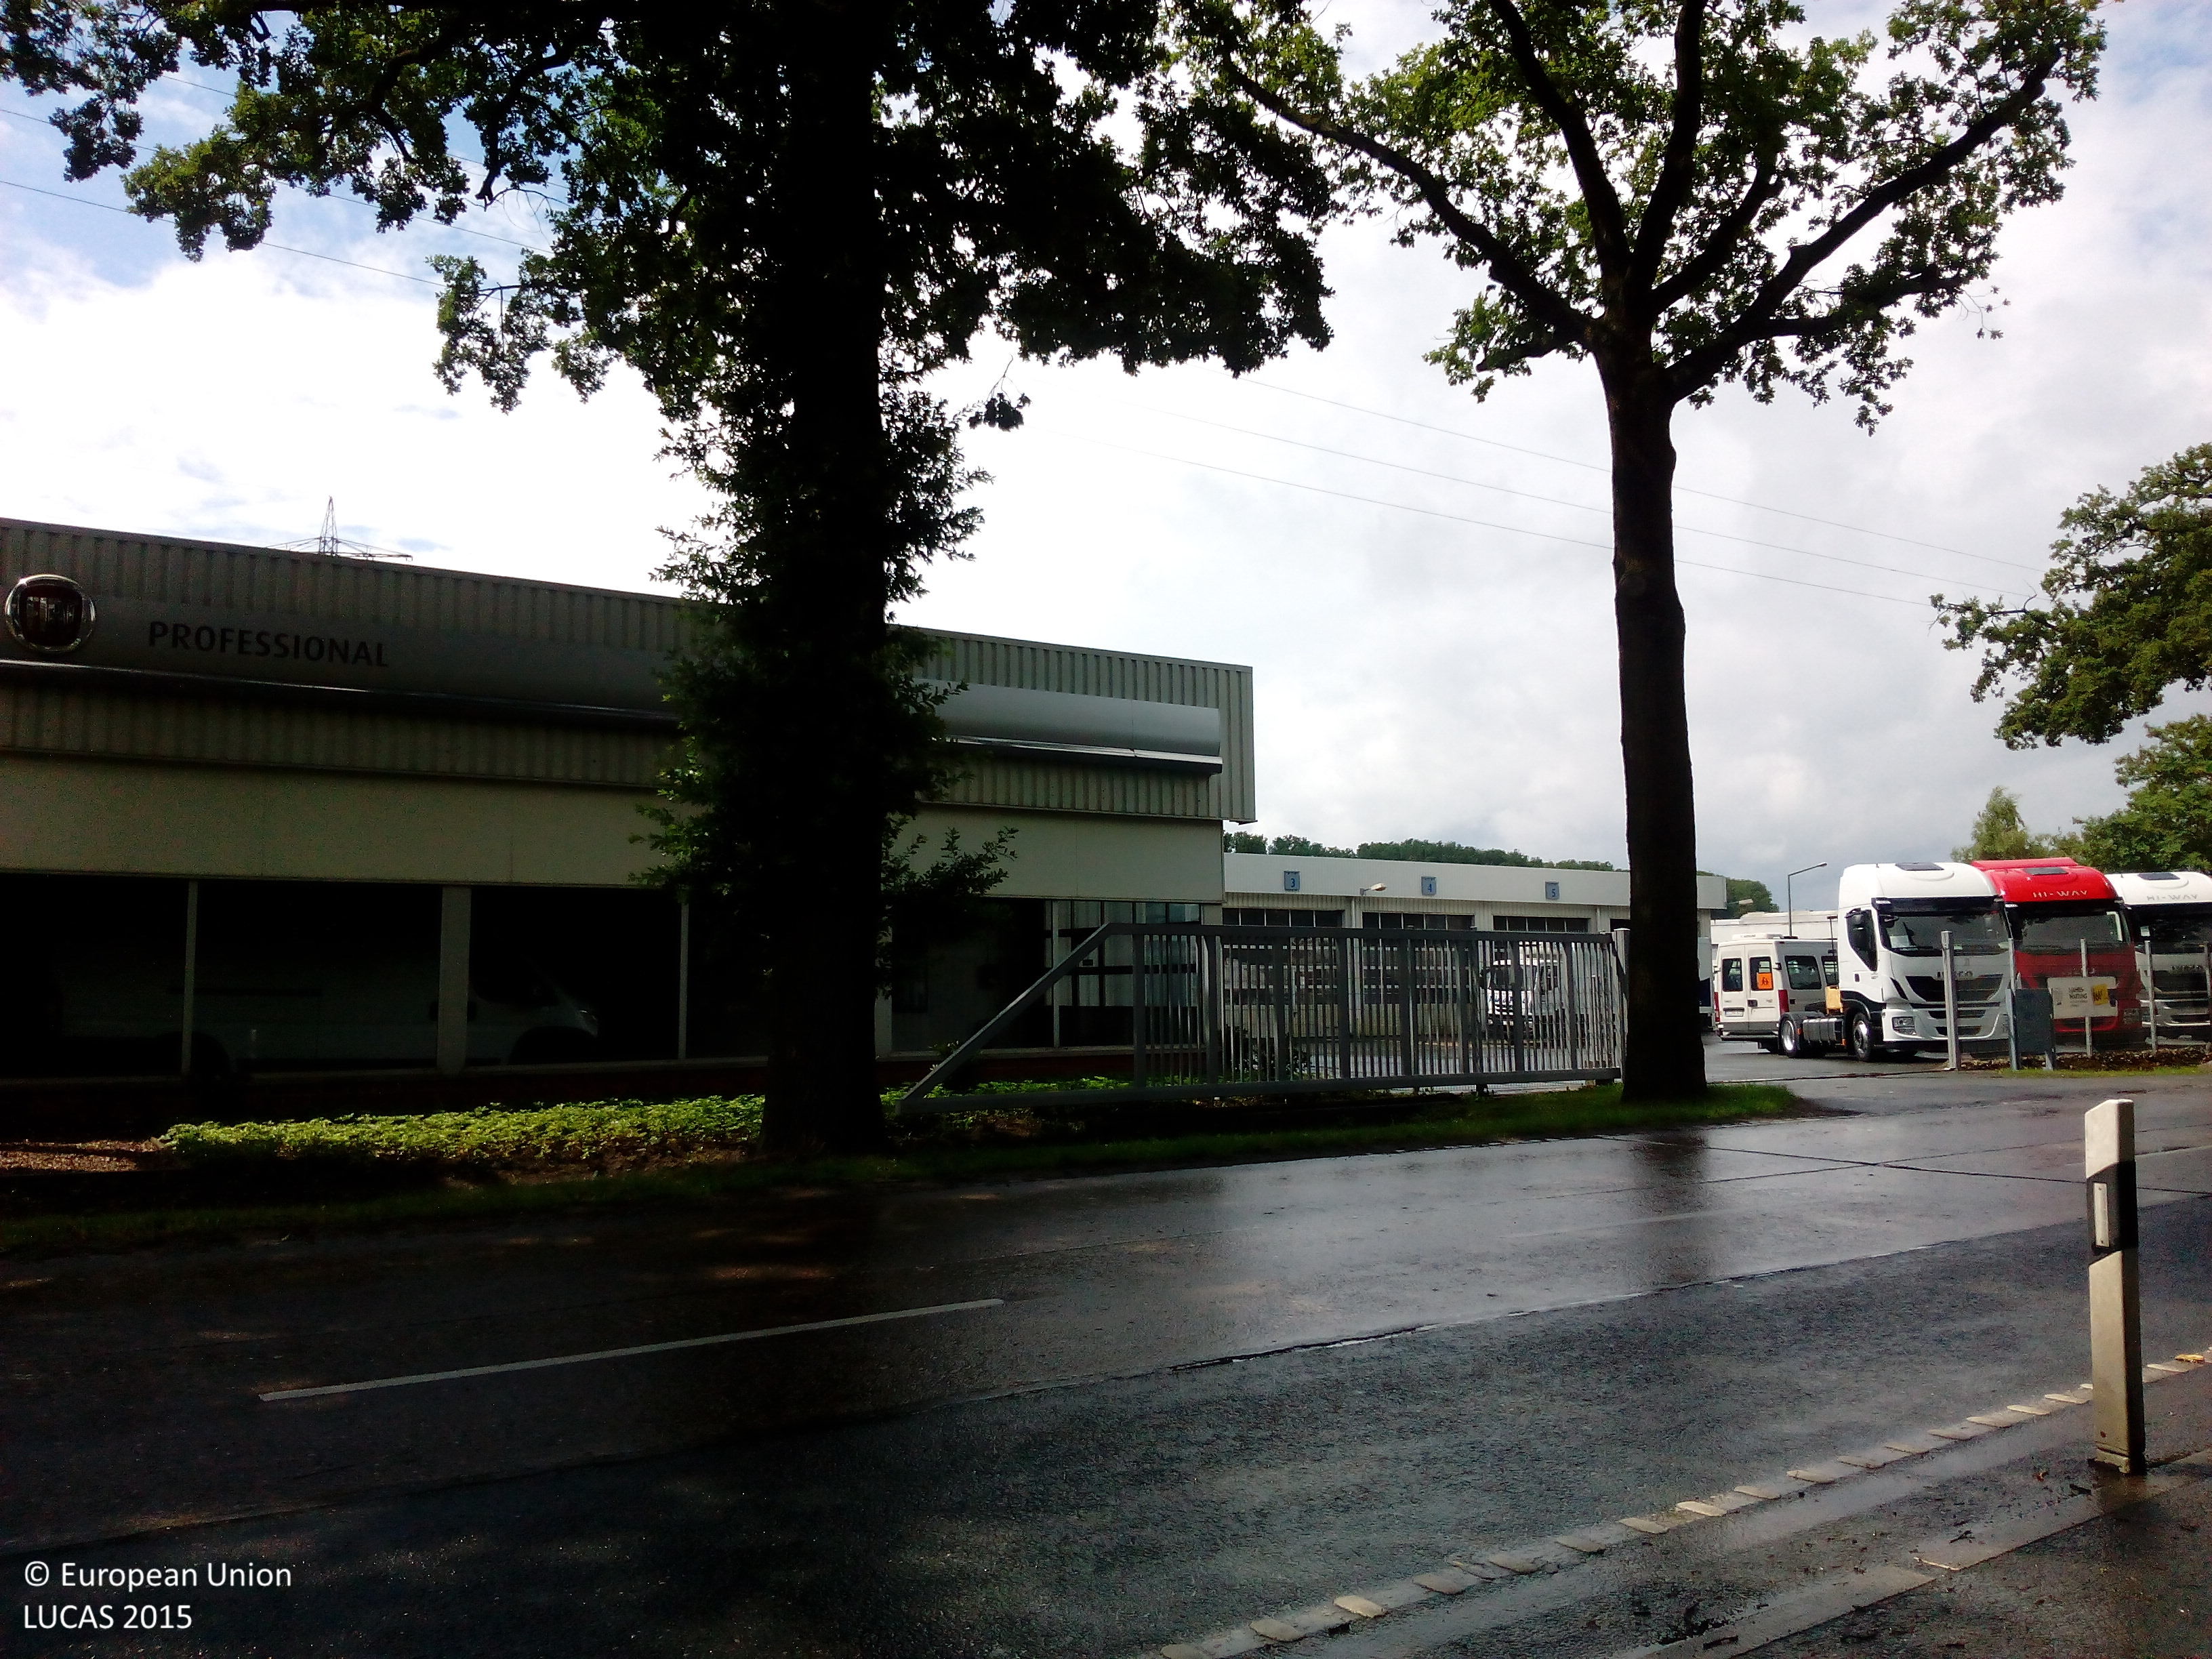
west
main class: Grassland
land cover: Grassland without tree/shrub cover
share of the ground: > 75 %
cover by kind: herbaceous plants 100 %
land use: Agriculture (excluding fallow land and kitchen gardens)
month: July
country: DE
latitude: 52.3070
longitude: 8.0205
